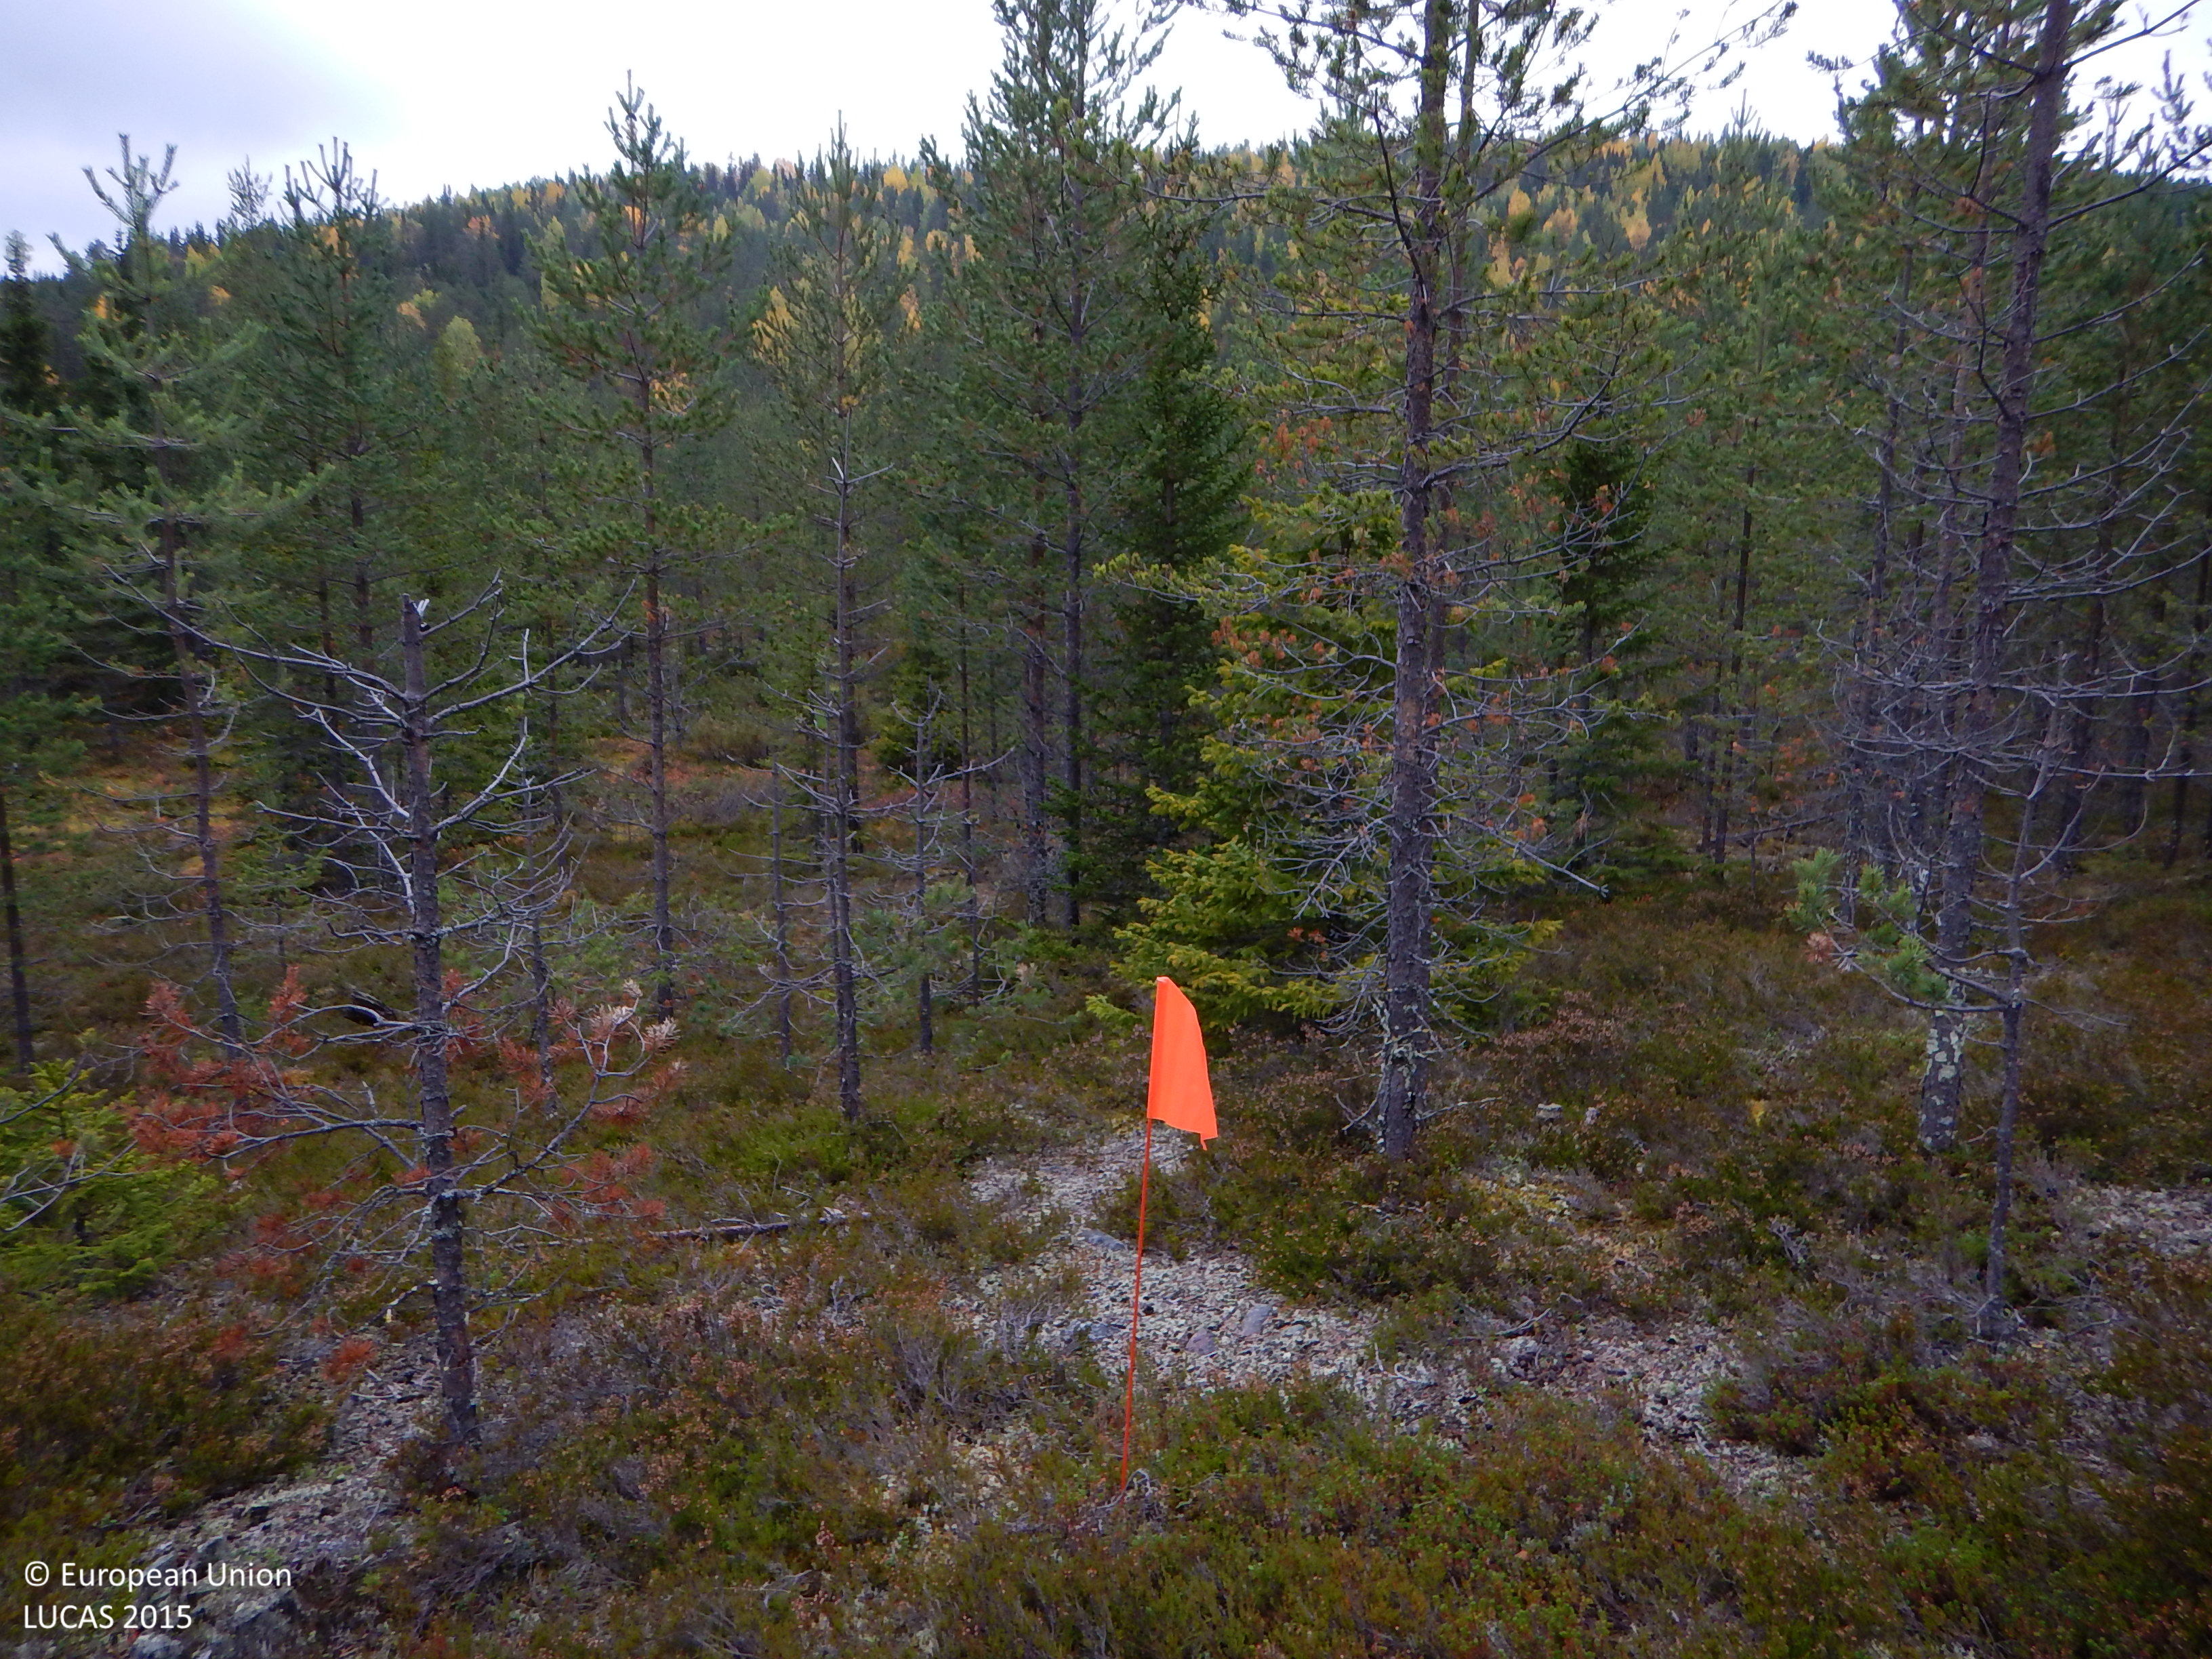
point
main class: Woodland
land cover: Pine dominated coniferous woodland
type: boreal forest
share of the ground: 50 - 75 %
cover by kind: coniferous forest trees 60 %, shrubs 15 %, lichens and mosses 15 %, herbaceous plants 5 %, unconsolidated bare surface 5 %
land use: Forestry
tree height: > 5 m
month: September
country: SE
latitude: 65.0790
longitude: 19.1749
